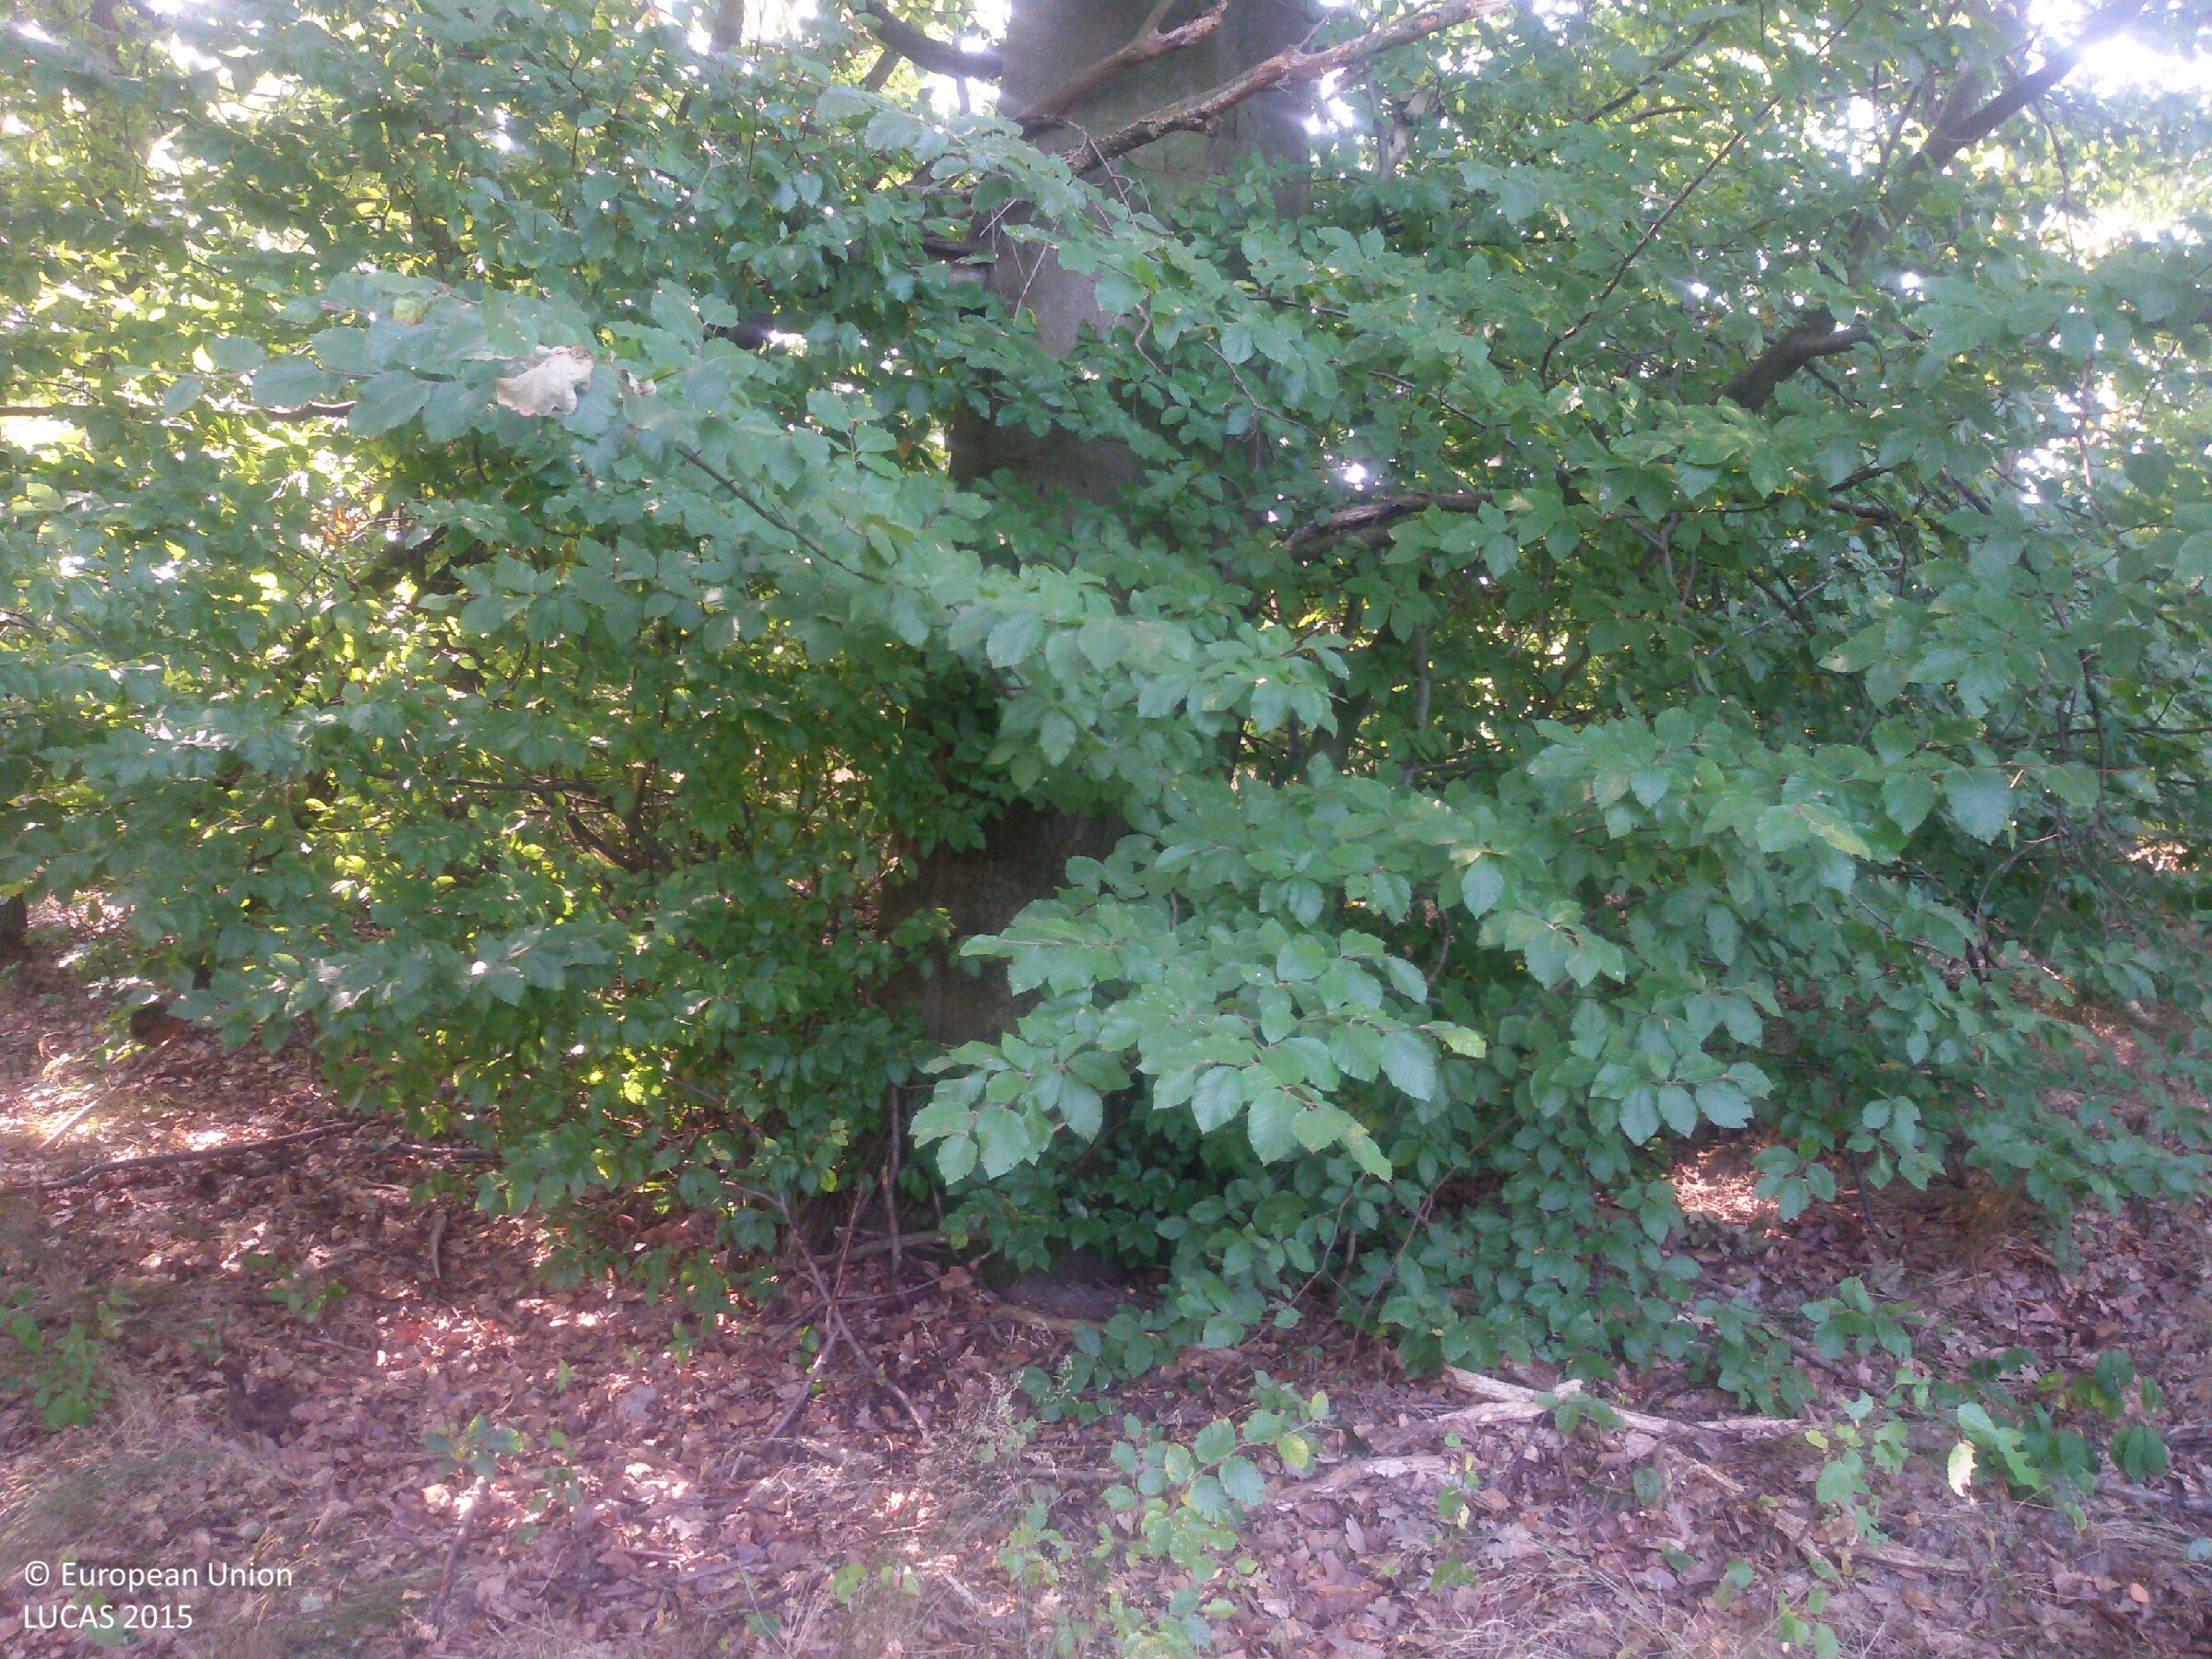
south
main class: Woodland
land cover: Broadleaved woodland
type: hemiboreal forest and nemoral coniferous forest and mixed broadleaved-coniferous forest
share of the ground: > 75 %
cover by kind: broadleaved forest trees 100 %
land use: Forestry
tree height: > 5 m
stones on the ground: < 10 %
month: August
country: PL
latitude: 51.6571
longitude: 20.6943
